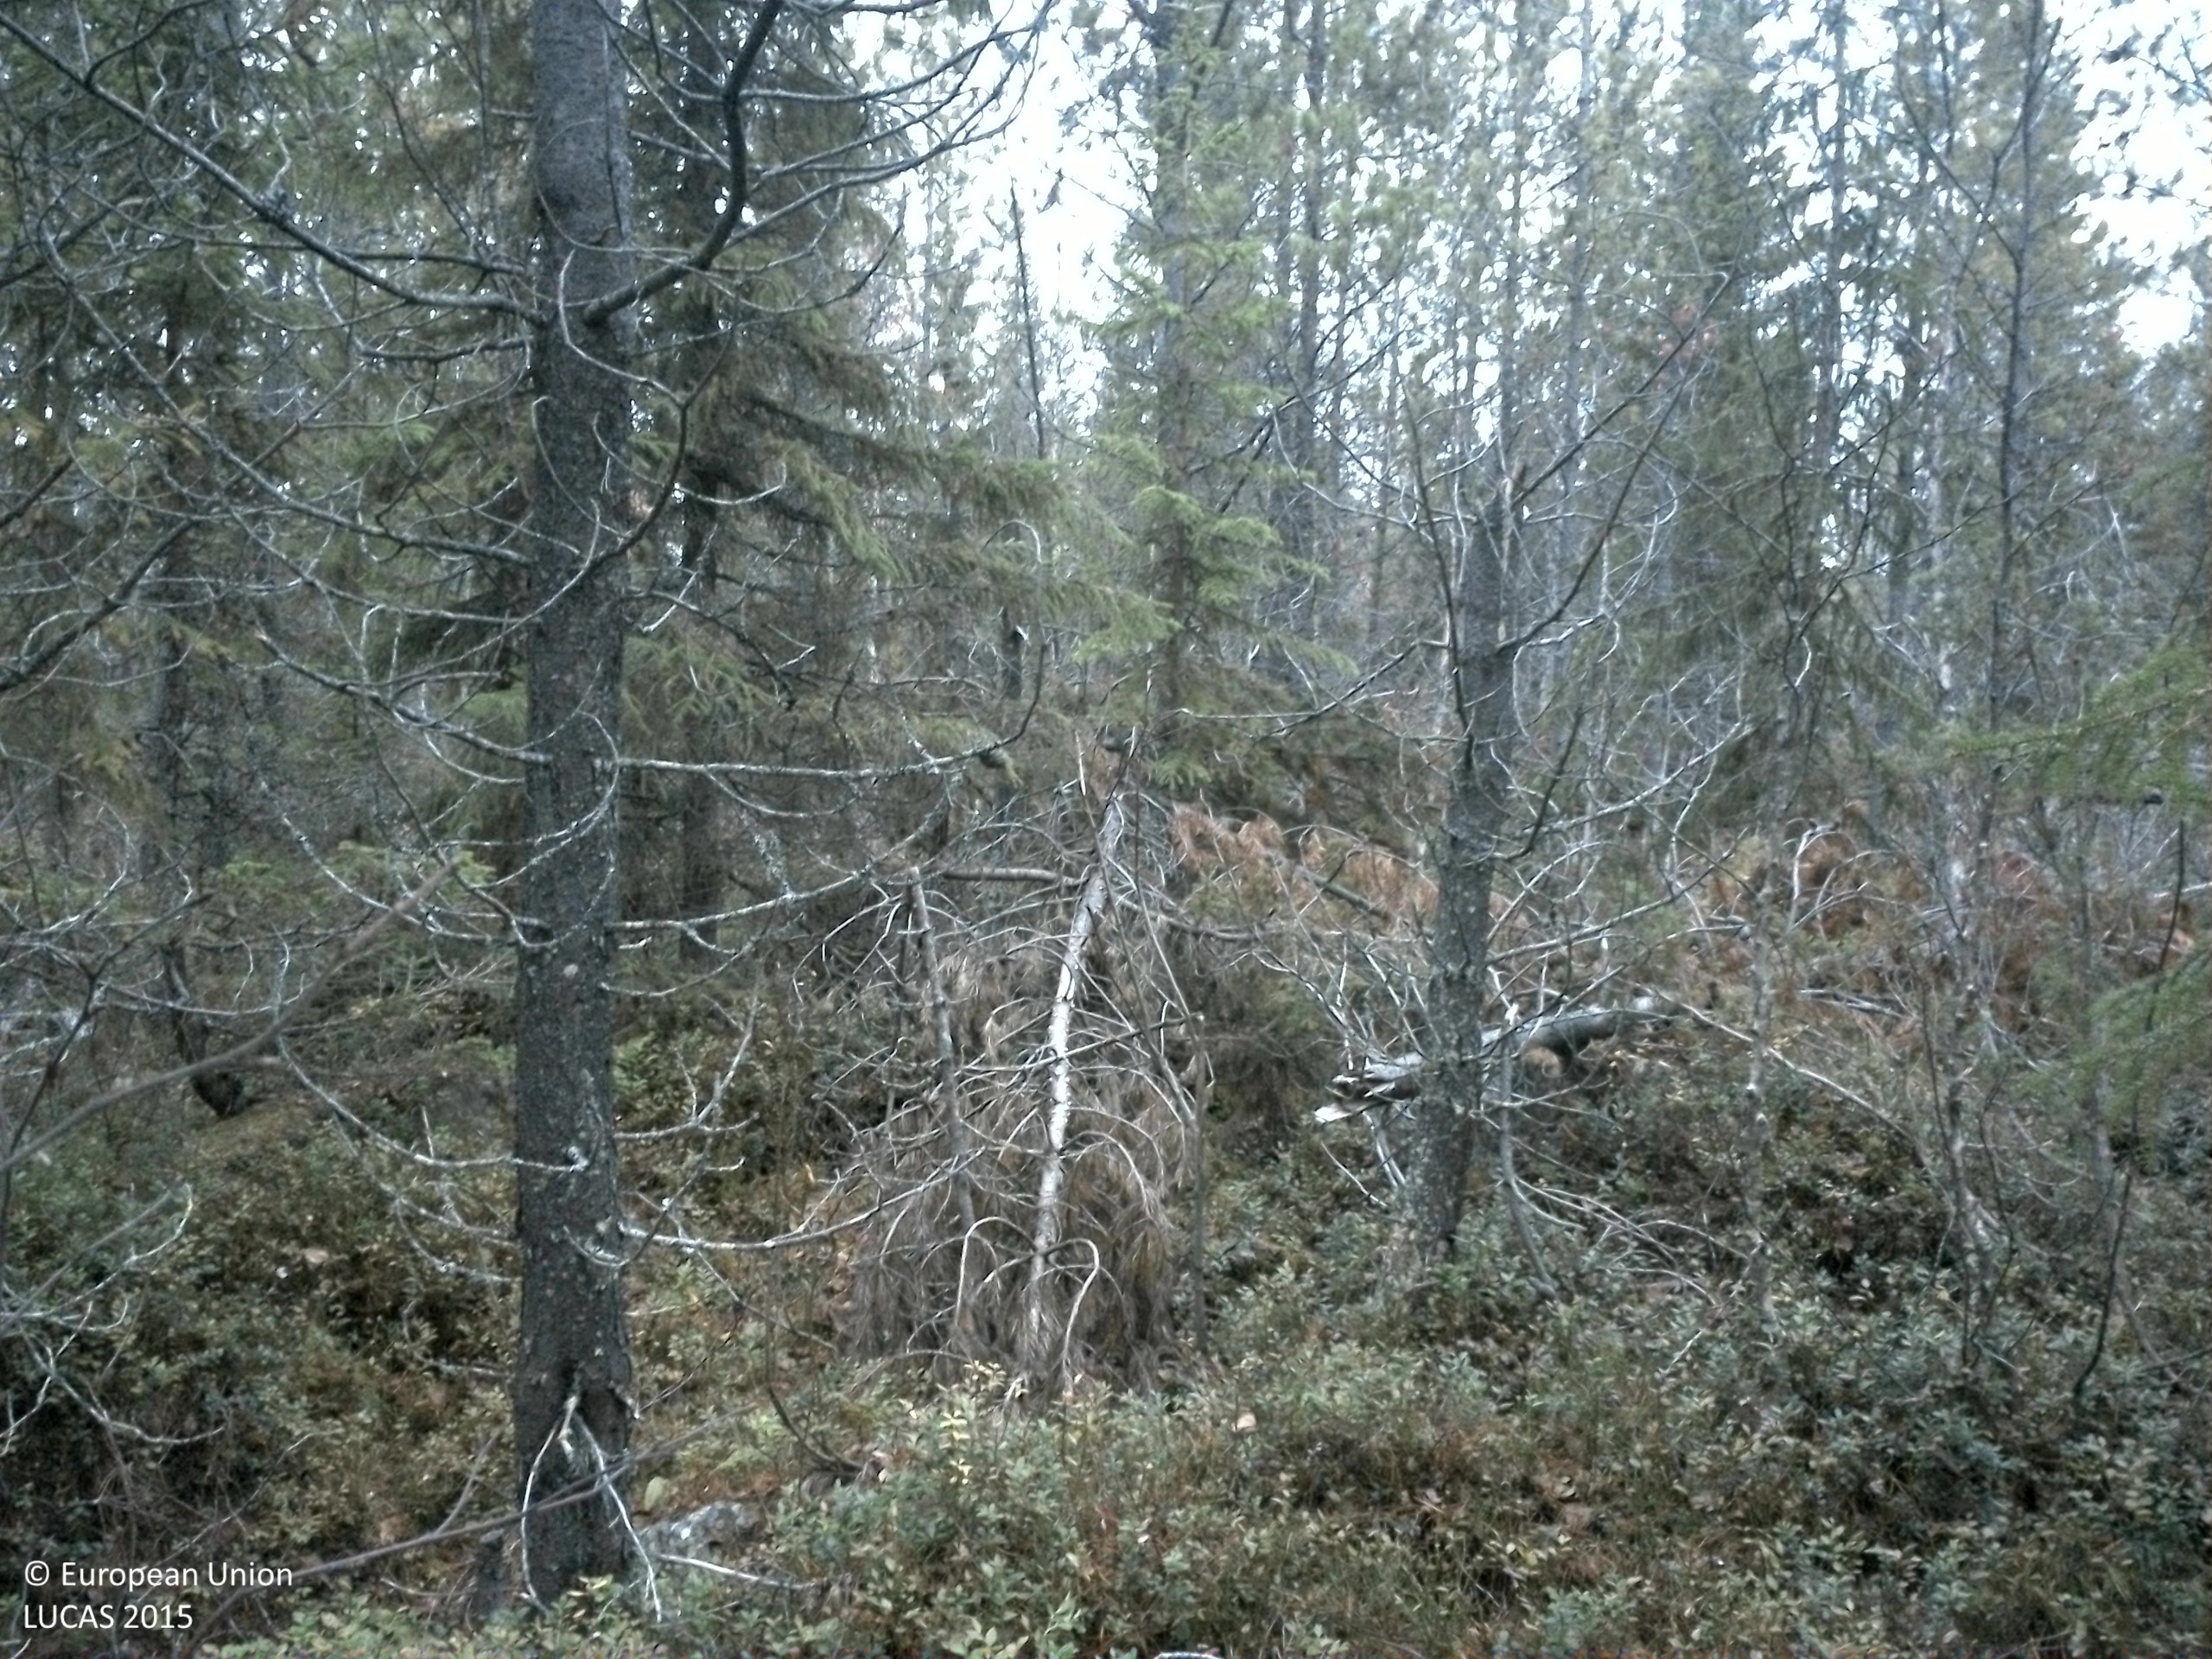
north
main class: Woodland
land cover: Pine dominated mixed woodland
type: exotic forest
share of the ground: 50 - 75 %
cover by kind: coniferous forest trees 40 %, shrubs 25 %, broadleaved forest trees 15 %, lichens and mosses 15 %, herbaceous plants 5 %
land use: Forestry
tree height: > 5 m
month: October
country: SE
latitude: 64.2809
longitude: 15.6093
